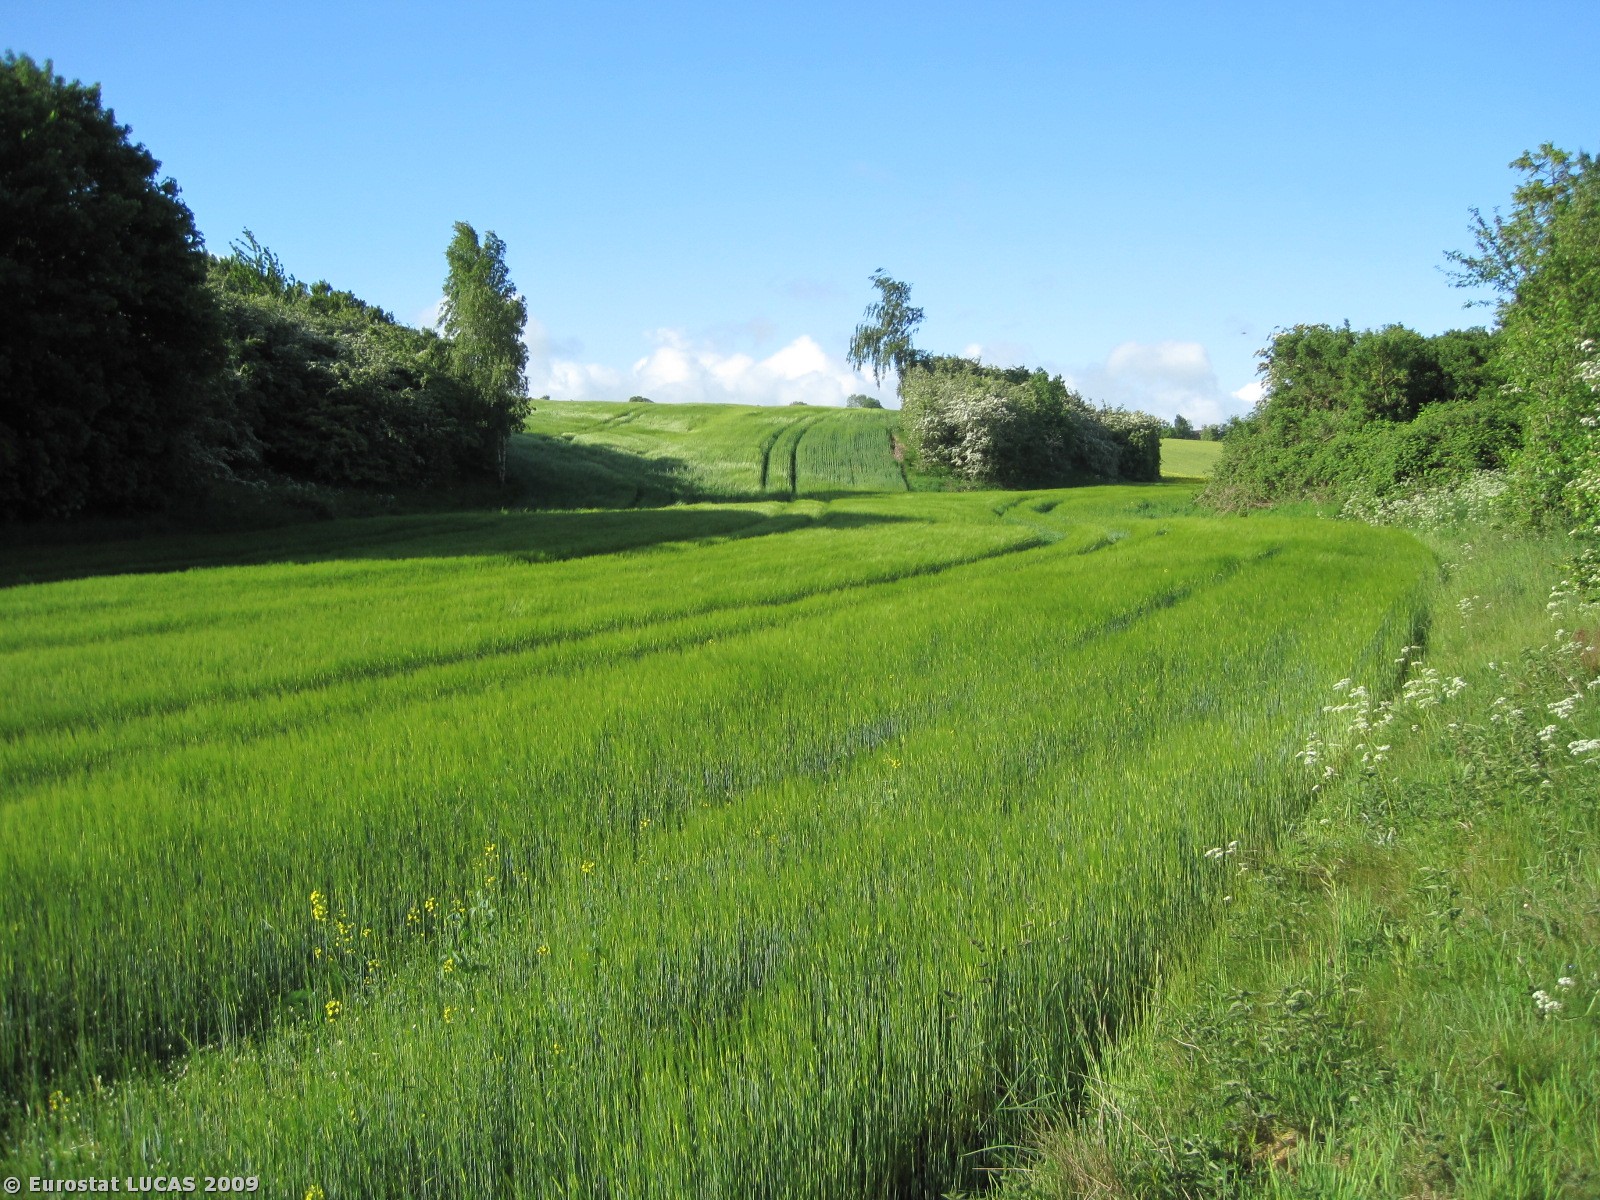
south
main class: Woodland
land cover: Broadleaved woodland
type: mesophytic deciduous forest
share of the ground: > 75 %
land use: Unused
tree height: > 5 m
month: May
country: DK
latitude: 56.5652
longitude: 10.1138
